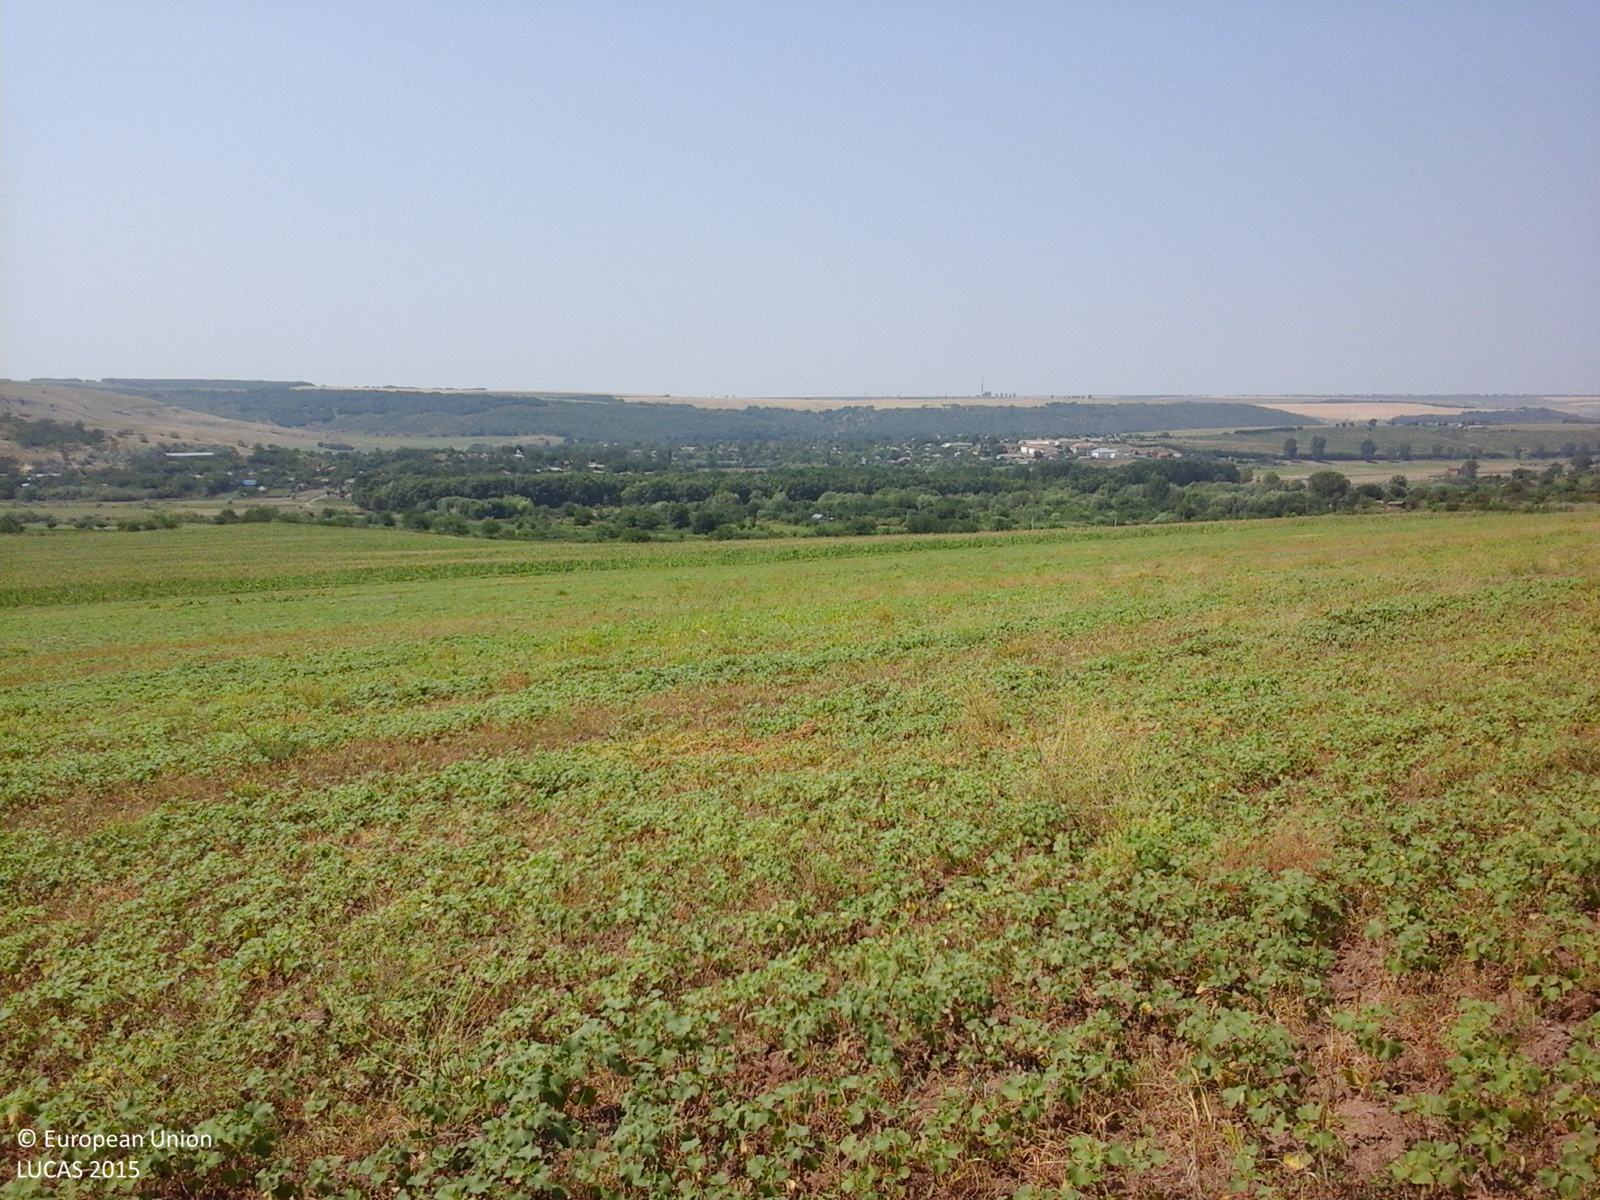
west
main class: Grassland
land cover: Spontaneously vegetated surfaces
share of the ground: > 75 %
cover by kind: herbaceous plants 100 %
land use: Agriculture (excluding fallow land and kitchen gardens)
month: July
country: RO
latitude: 45.8090
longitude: 27.9677
